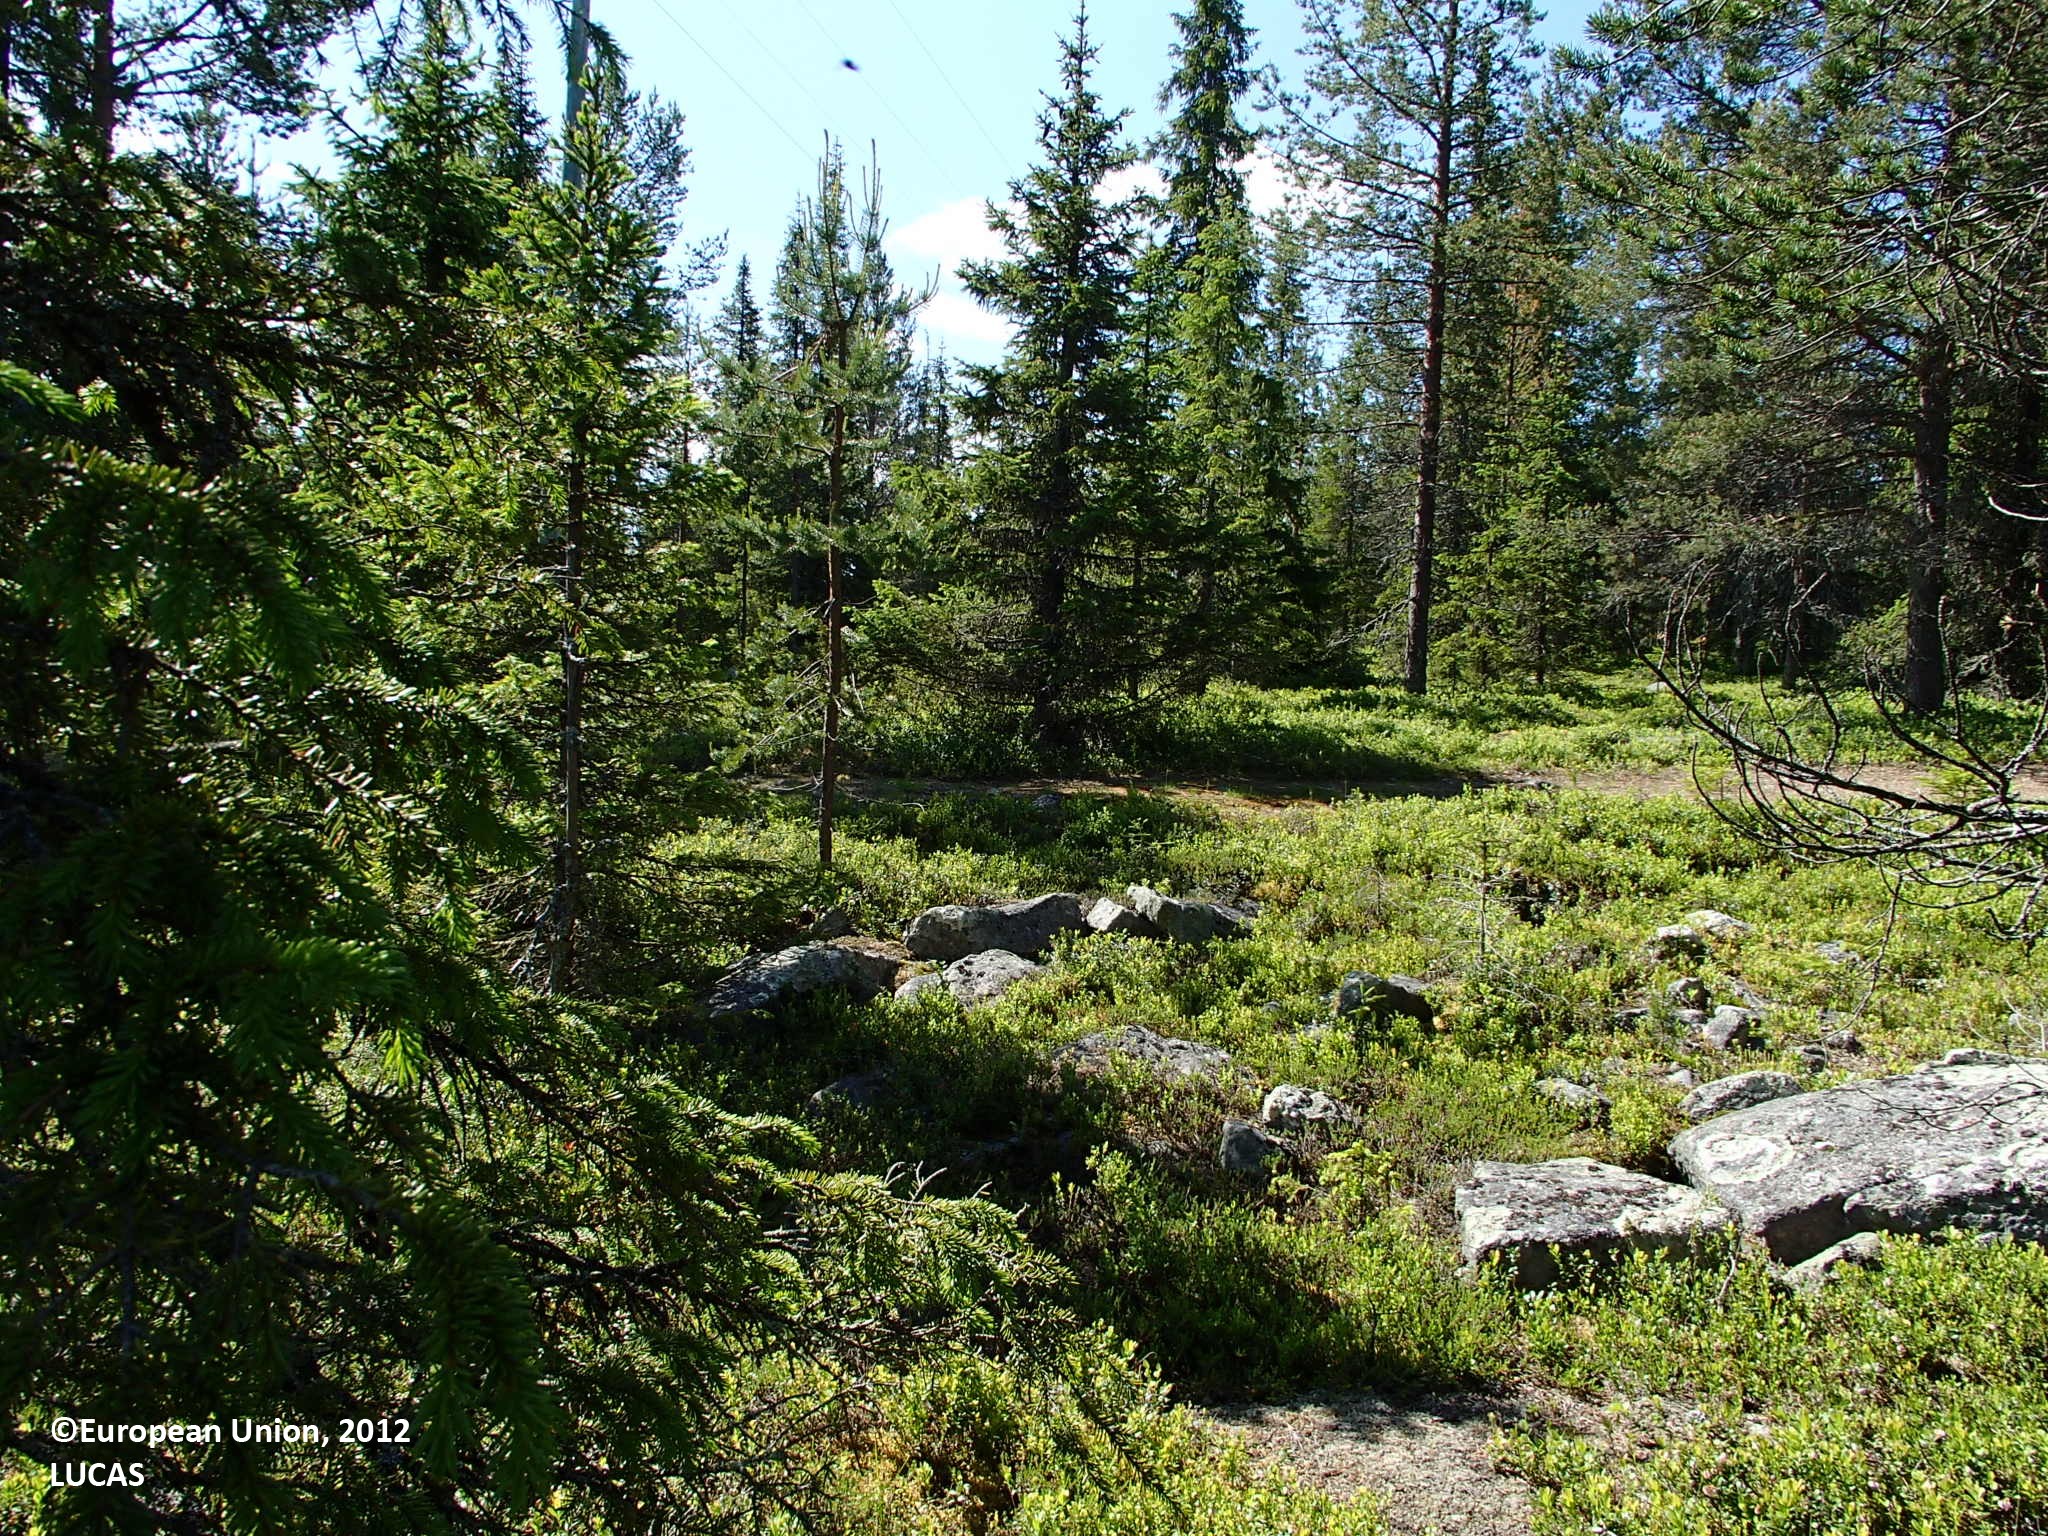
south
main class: Woodland
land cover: Other coniferous woodland
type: boreal forest
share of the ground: > 75 %
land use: Forestry
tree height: > 5 m
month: July
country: FI
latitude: 67.3405
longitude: 26.0431
